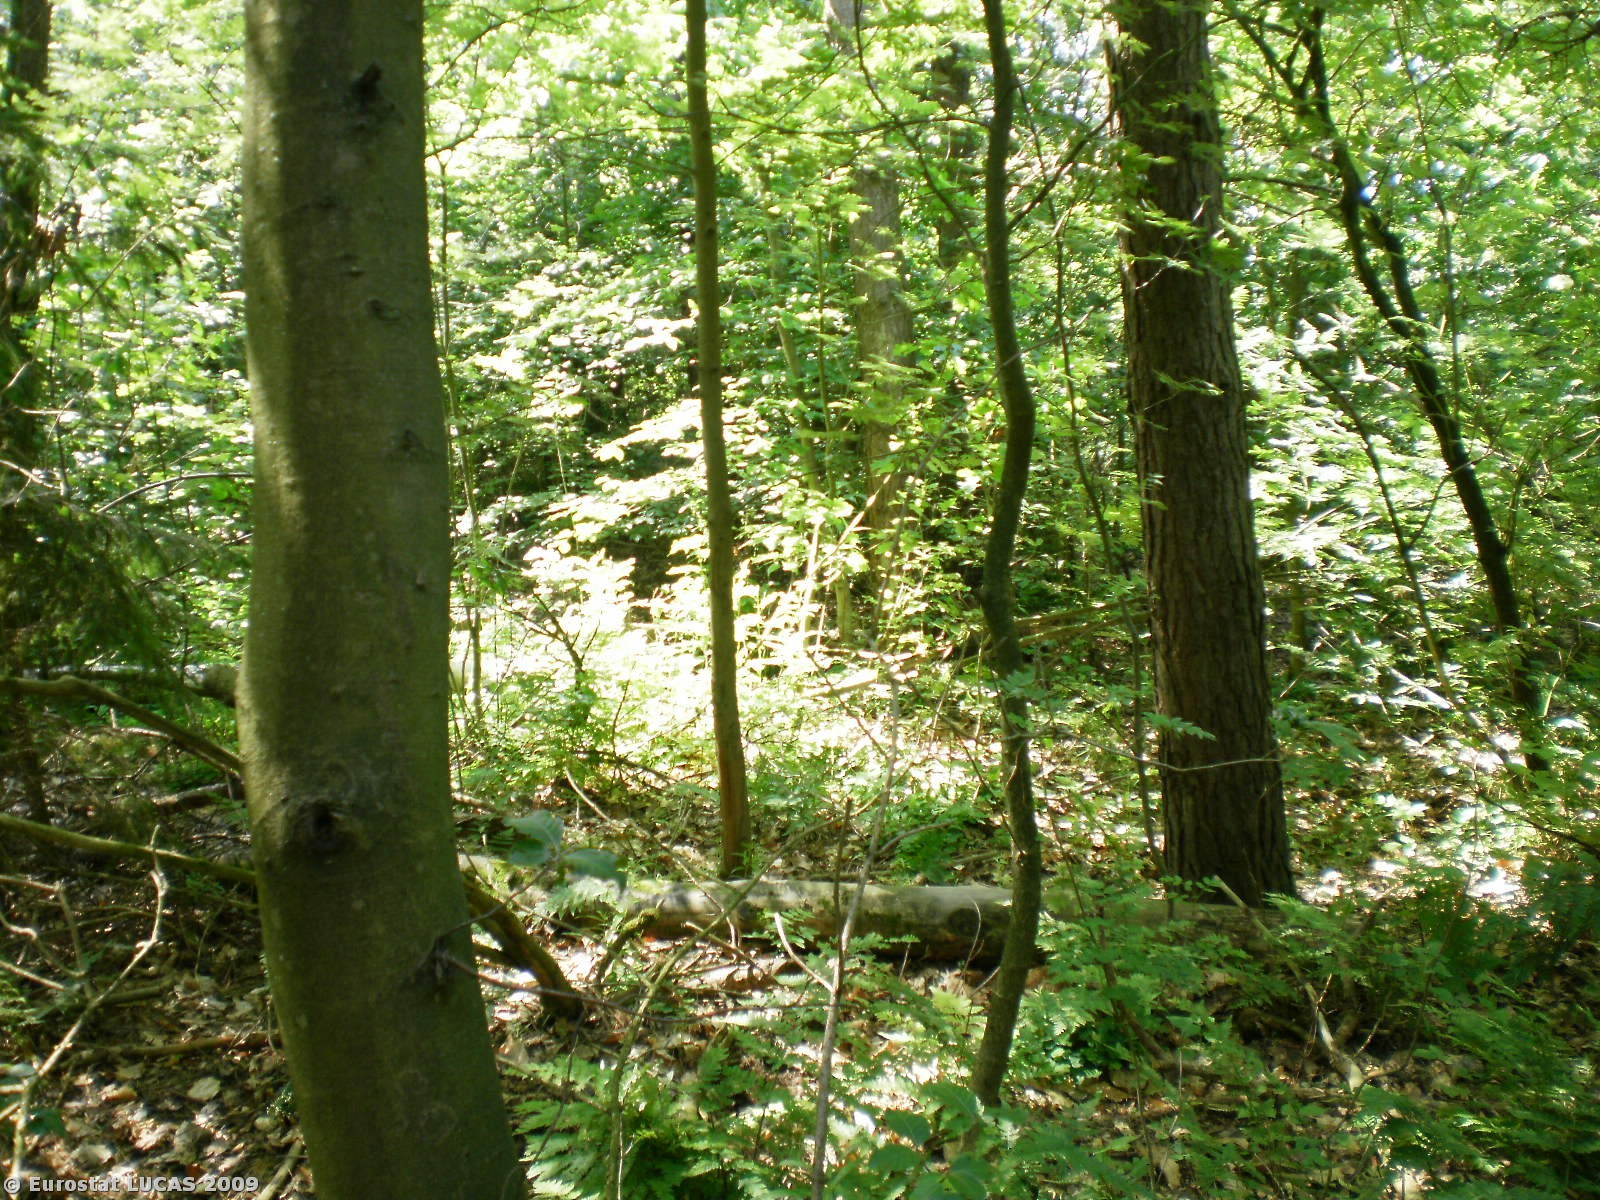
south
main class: Woodland
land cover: Mixed woodland
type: hemiboreal forest and nemoral coniferous forest and mixed broadleaved-coniferous forest
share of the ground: > 75 %
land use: Forestry
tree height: > 5 m
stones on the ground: < 10 %
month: June
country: PL
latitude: 54.5521
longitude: 17.3225
